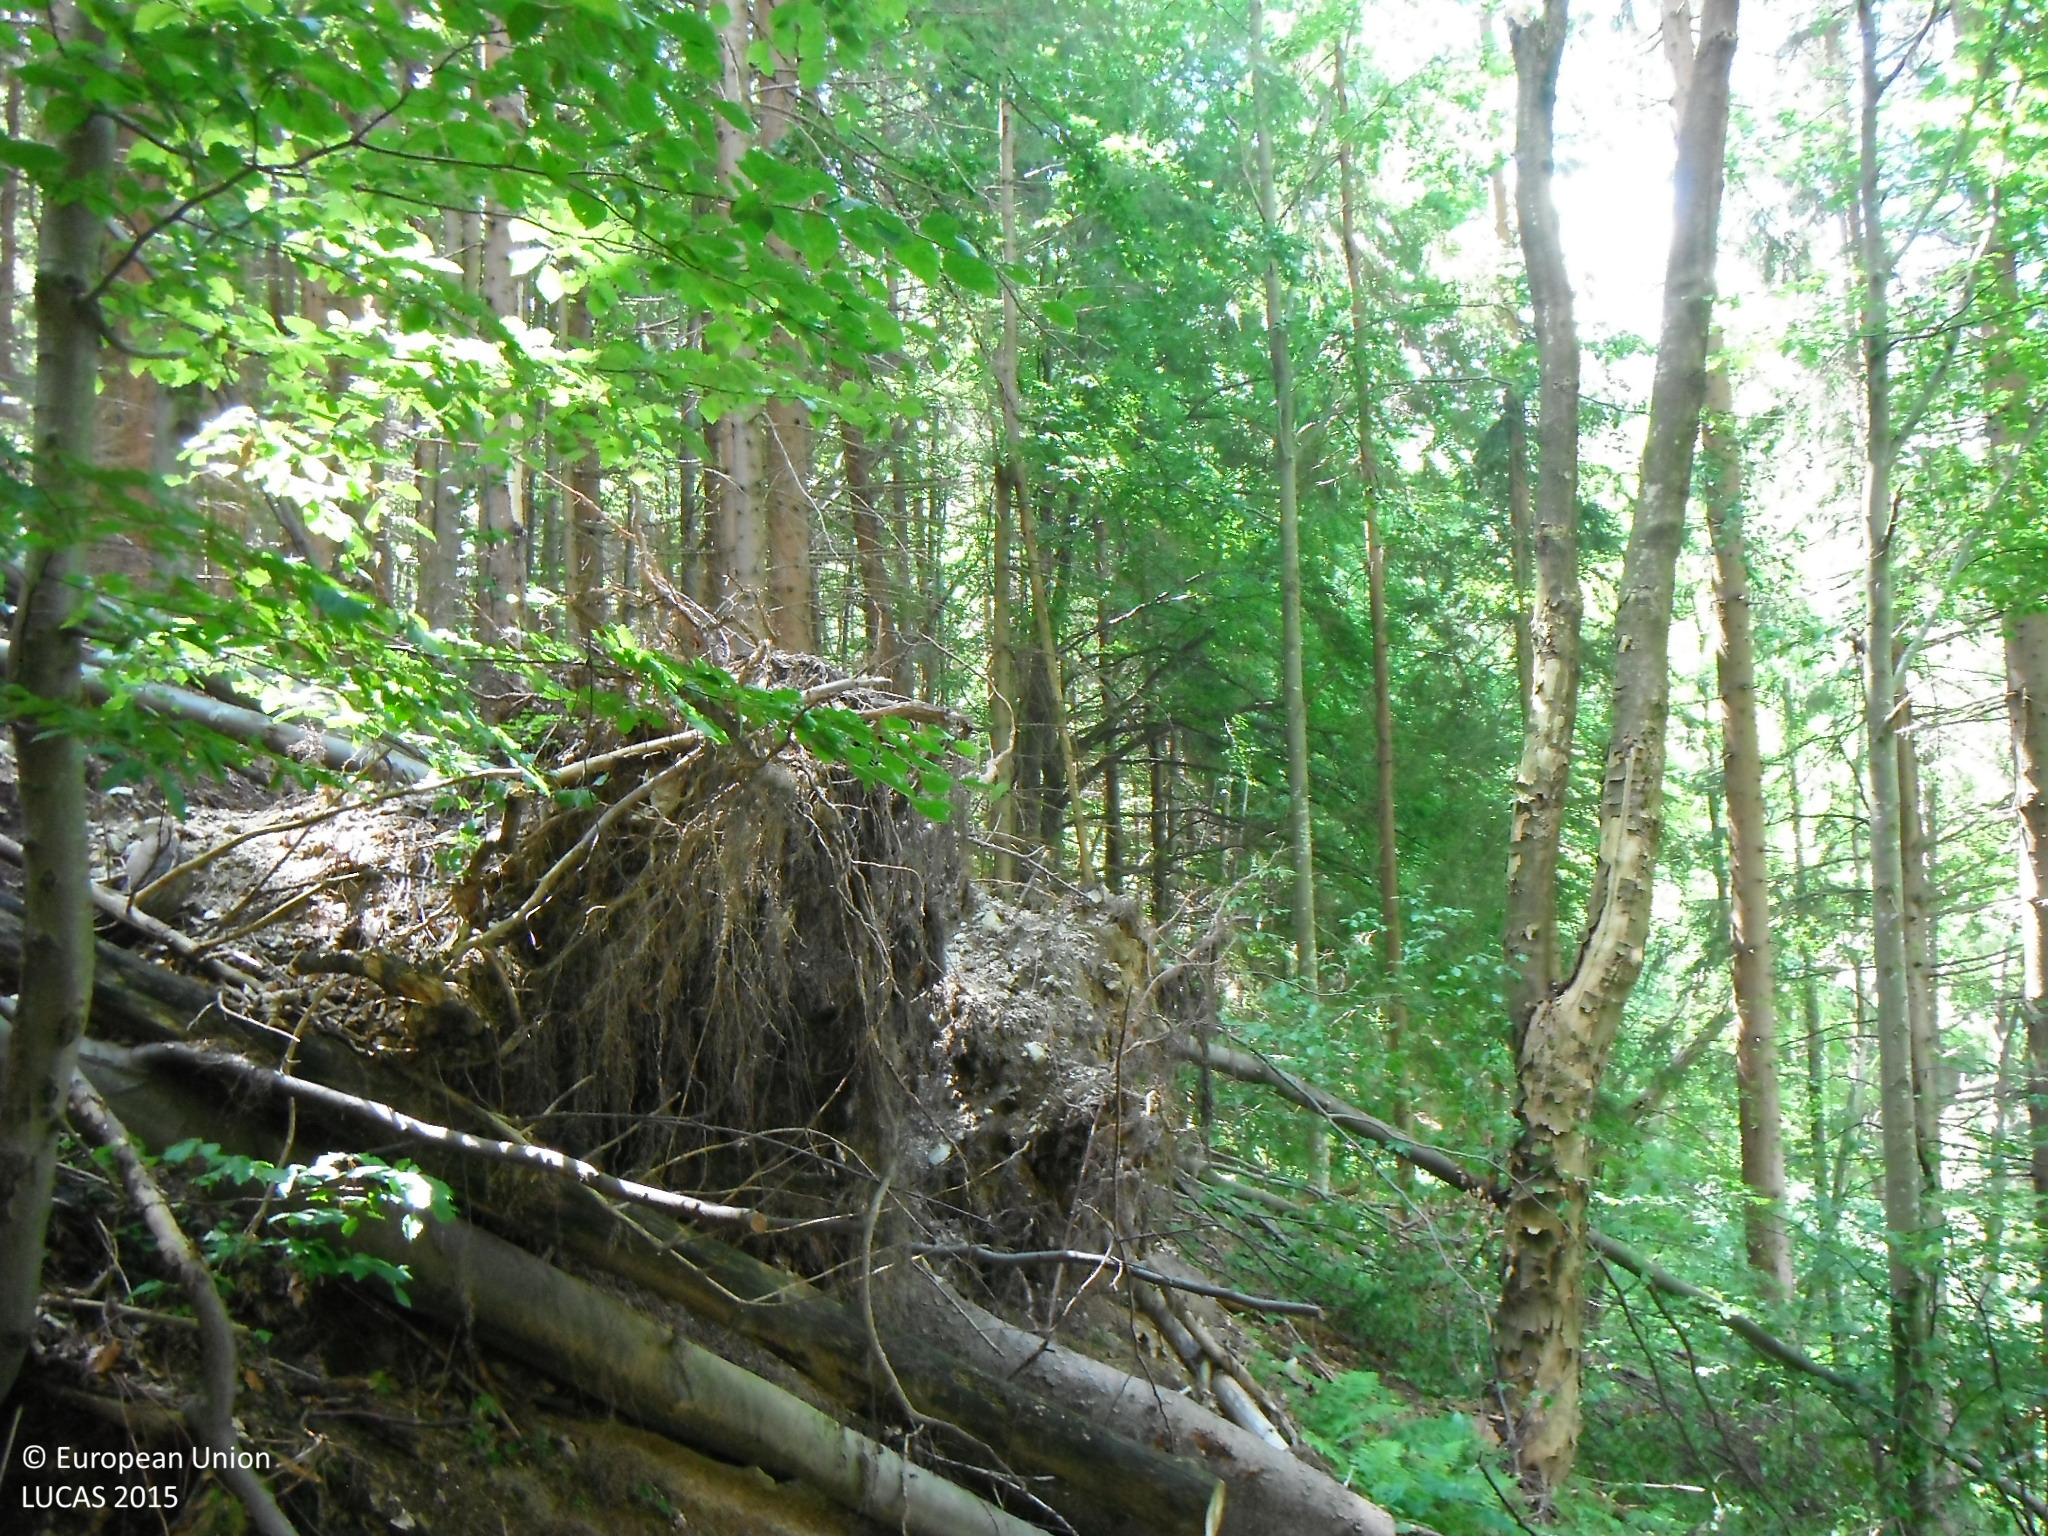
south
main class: Woodland
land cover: Spruce dominated mixed woodland
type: hemiboreal forest and nemoral coniferous forest and mixed broadleaved-coniferous forest
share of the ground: > 75 %
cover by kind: coniferous forest trees 65 %, broadleaved forest trees 25 %, herbaceous plants 10 %
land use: Forestry
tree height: > 5 m
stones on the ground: 25 - 50 %
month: July
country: SK
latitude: 48.8979
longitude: 19.7265
